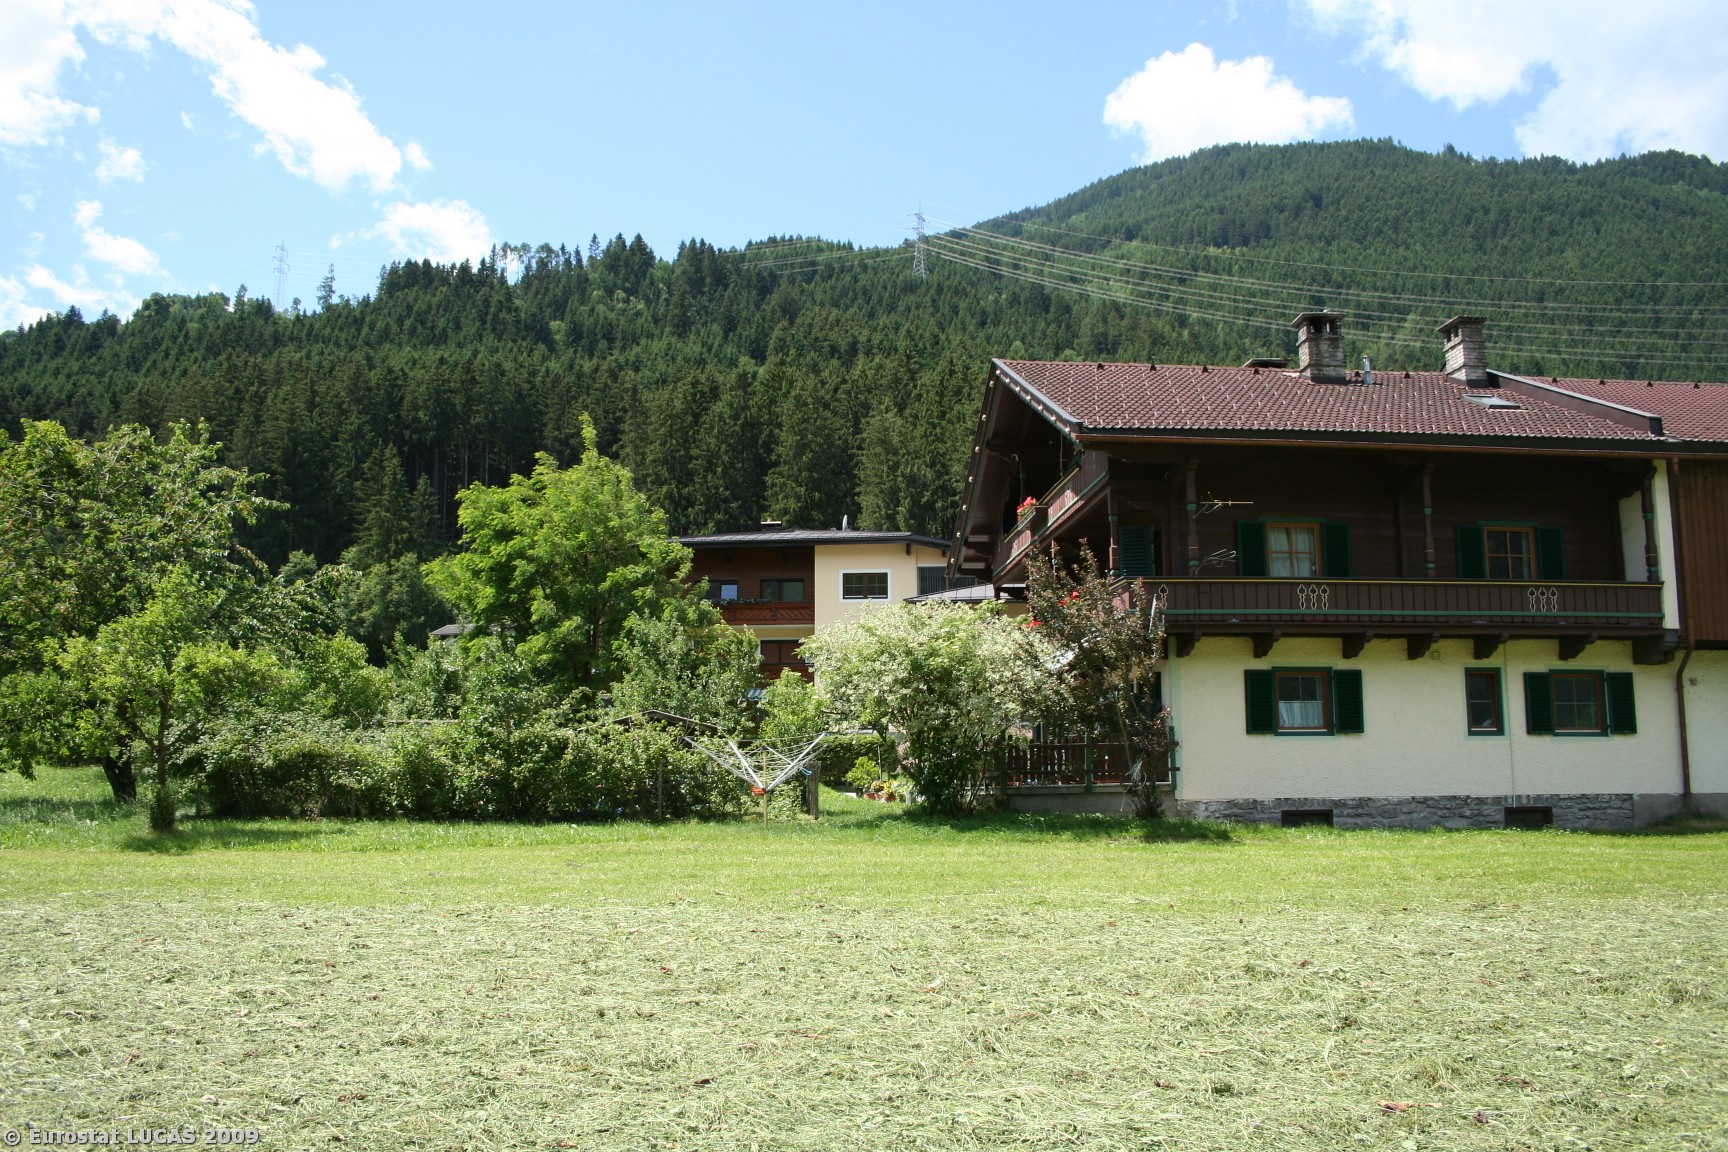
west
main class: Grassland
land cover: Grassland without tree/shrub cover
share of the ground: > 75 %
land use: Agriculture (excluding fallow land and kitchen gardens)
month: June
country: AT
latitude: 47.3076
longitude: 11.8635
